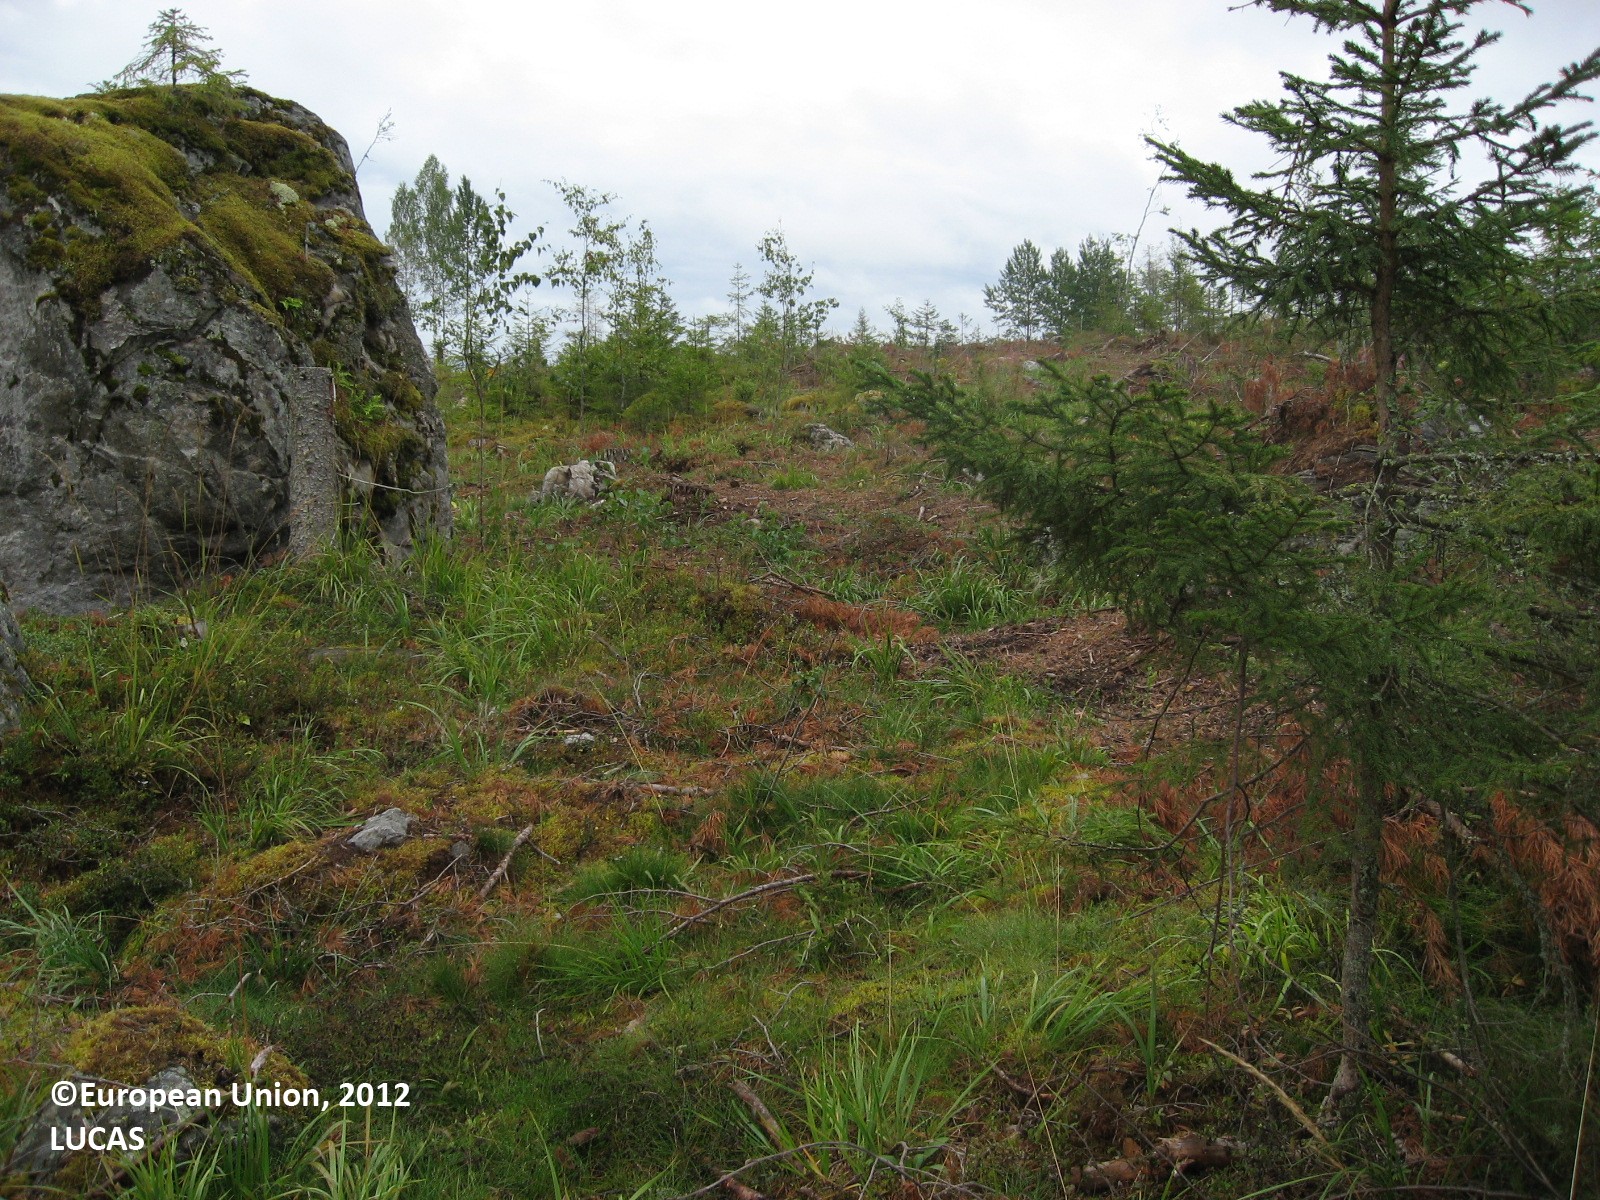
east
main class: Grassland
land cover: Grassland with sparse tree/shrub cover
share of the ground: 50 - 75 %
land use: Forestry
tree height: < 5 m
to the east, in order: Grassland with sparse tree/shrub cover; Spontaneously vegetated surfaces; Grassland with sparse tree/shrub cover; Spontaneously vegetated surfaces; Single bushes/trees; Paved roads, cycling and walking lanes
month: August
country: FI
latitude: 61.4564
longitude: 24.7563
